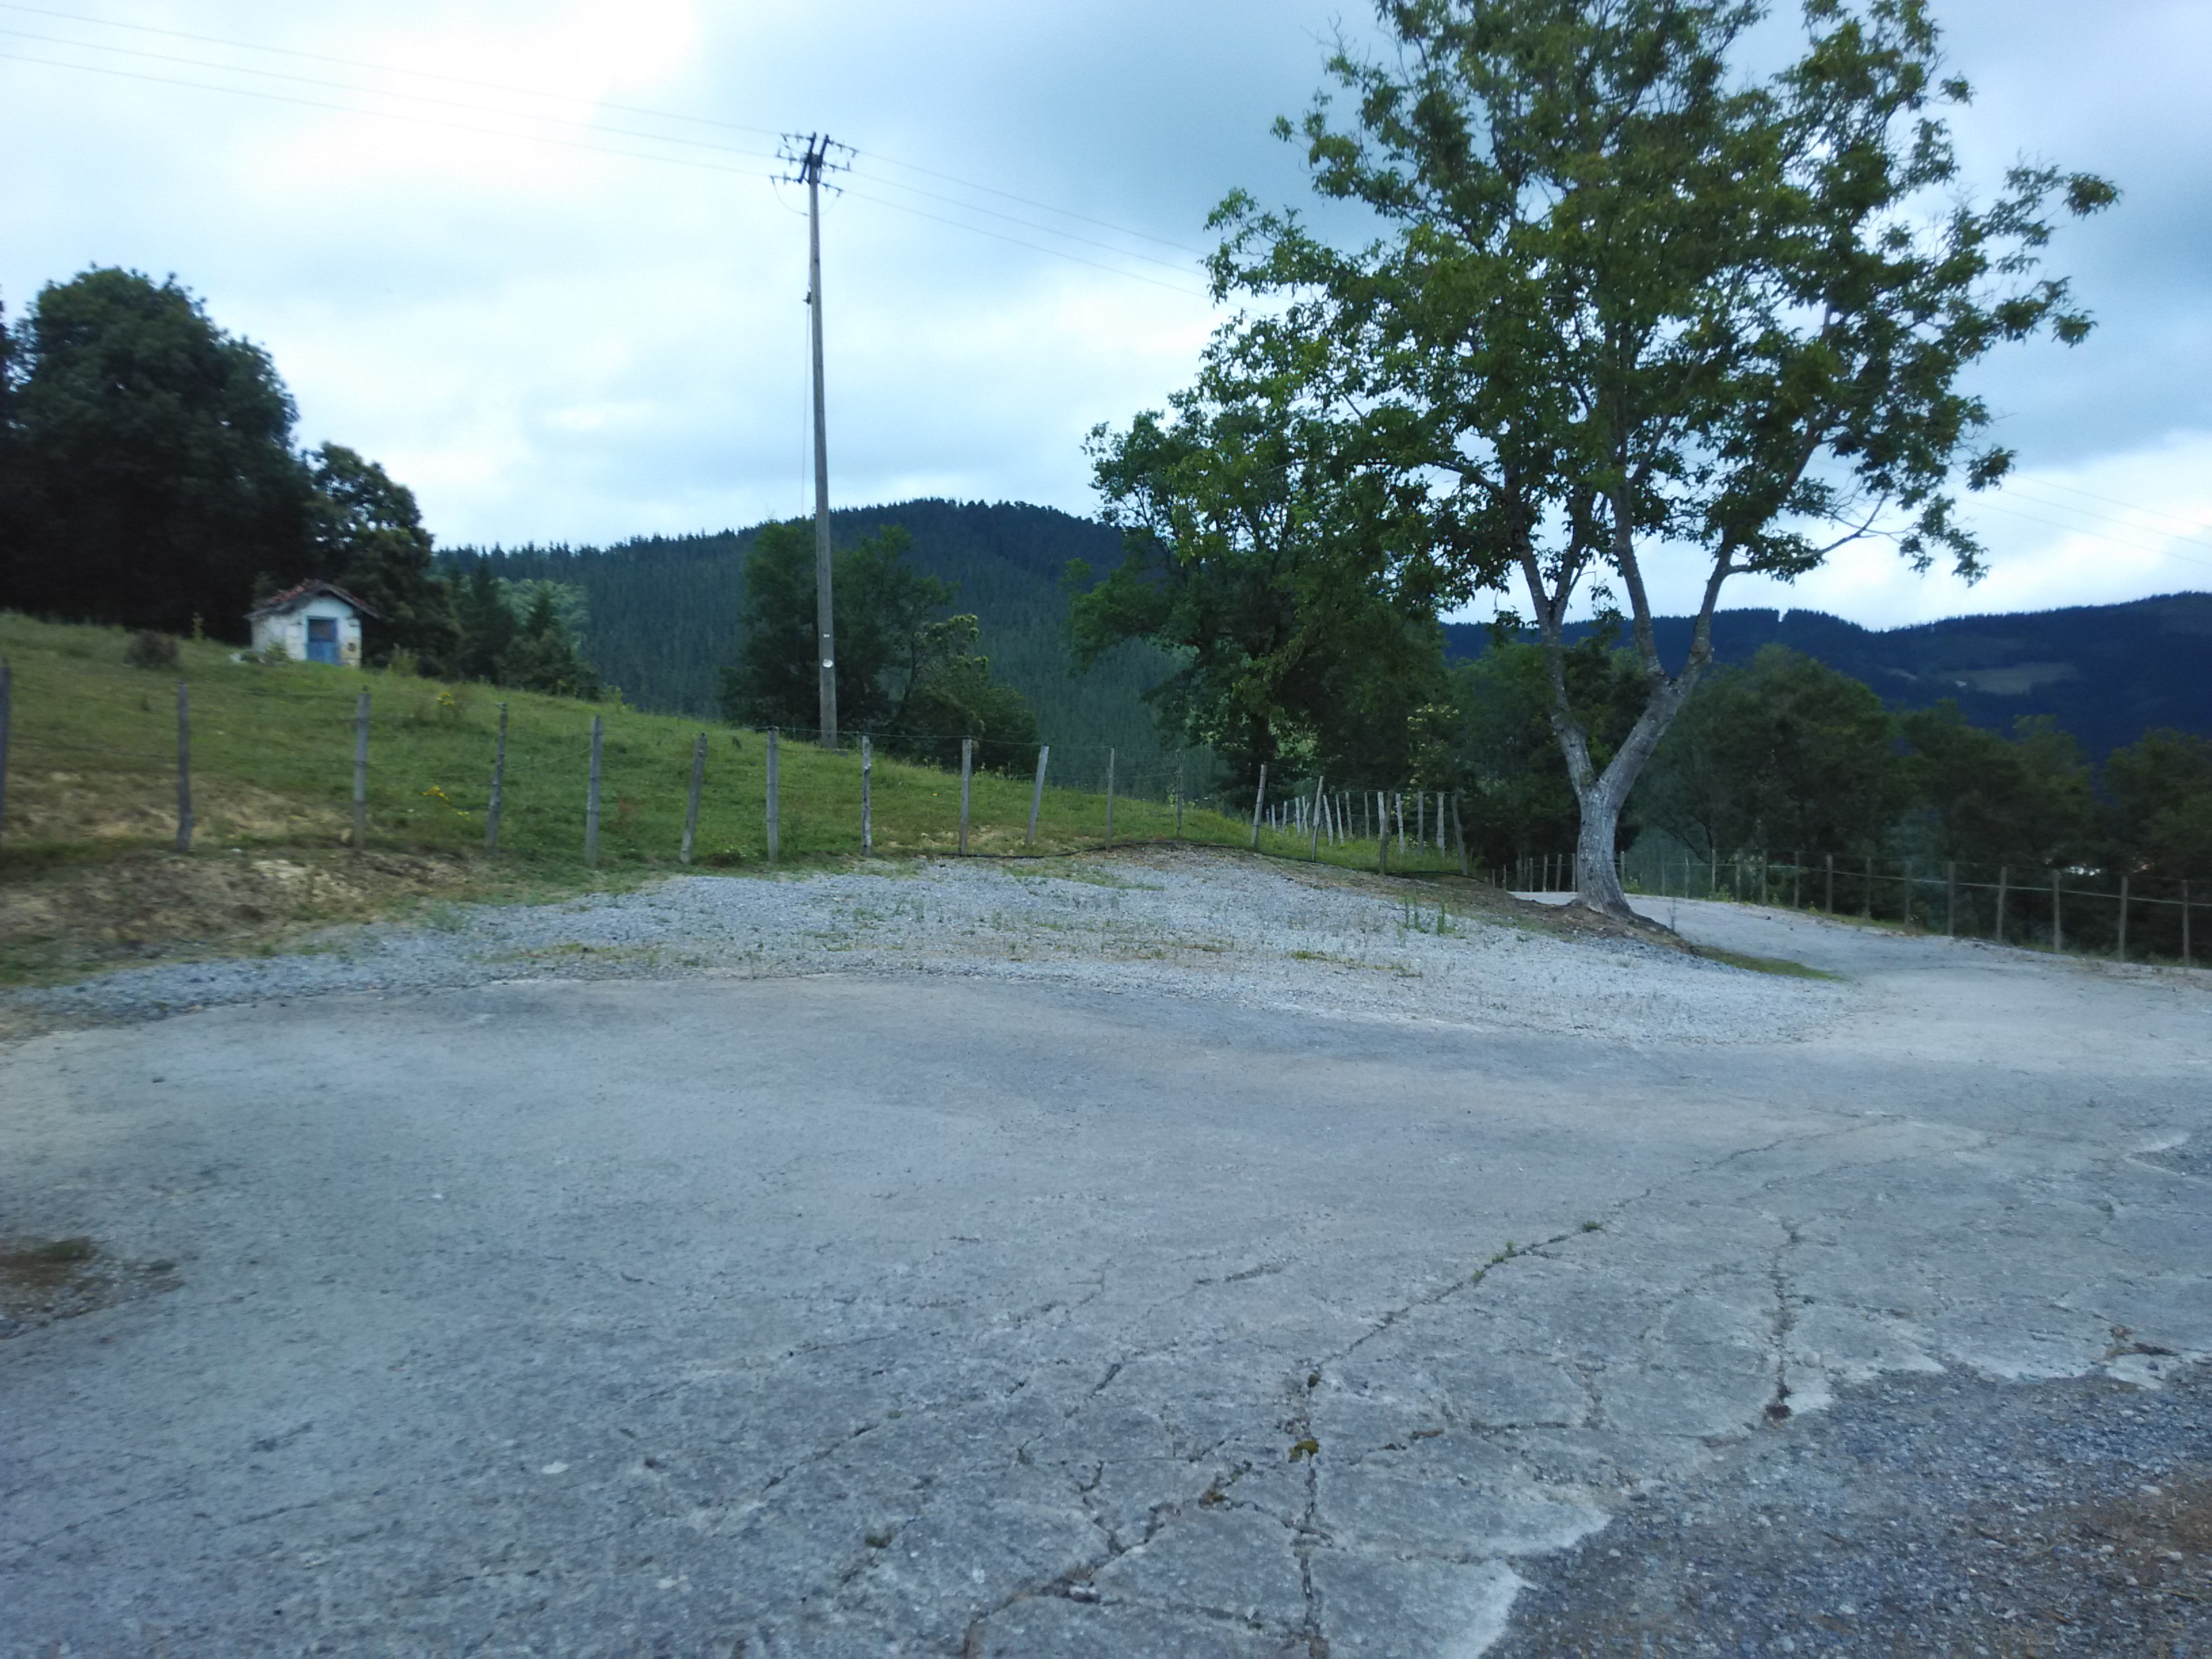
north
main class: Grassland
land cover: Grassland without tree/shrub cover
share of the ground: 50 - 75 %
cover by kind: herbaceous plants 70 %
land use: Agriculture (excluding fallow land and kitchen gardens)
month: July
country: ES
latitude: 43.1378
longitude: -2.4811
